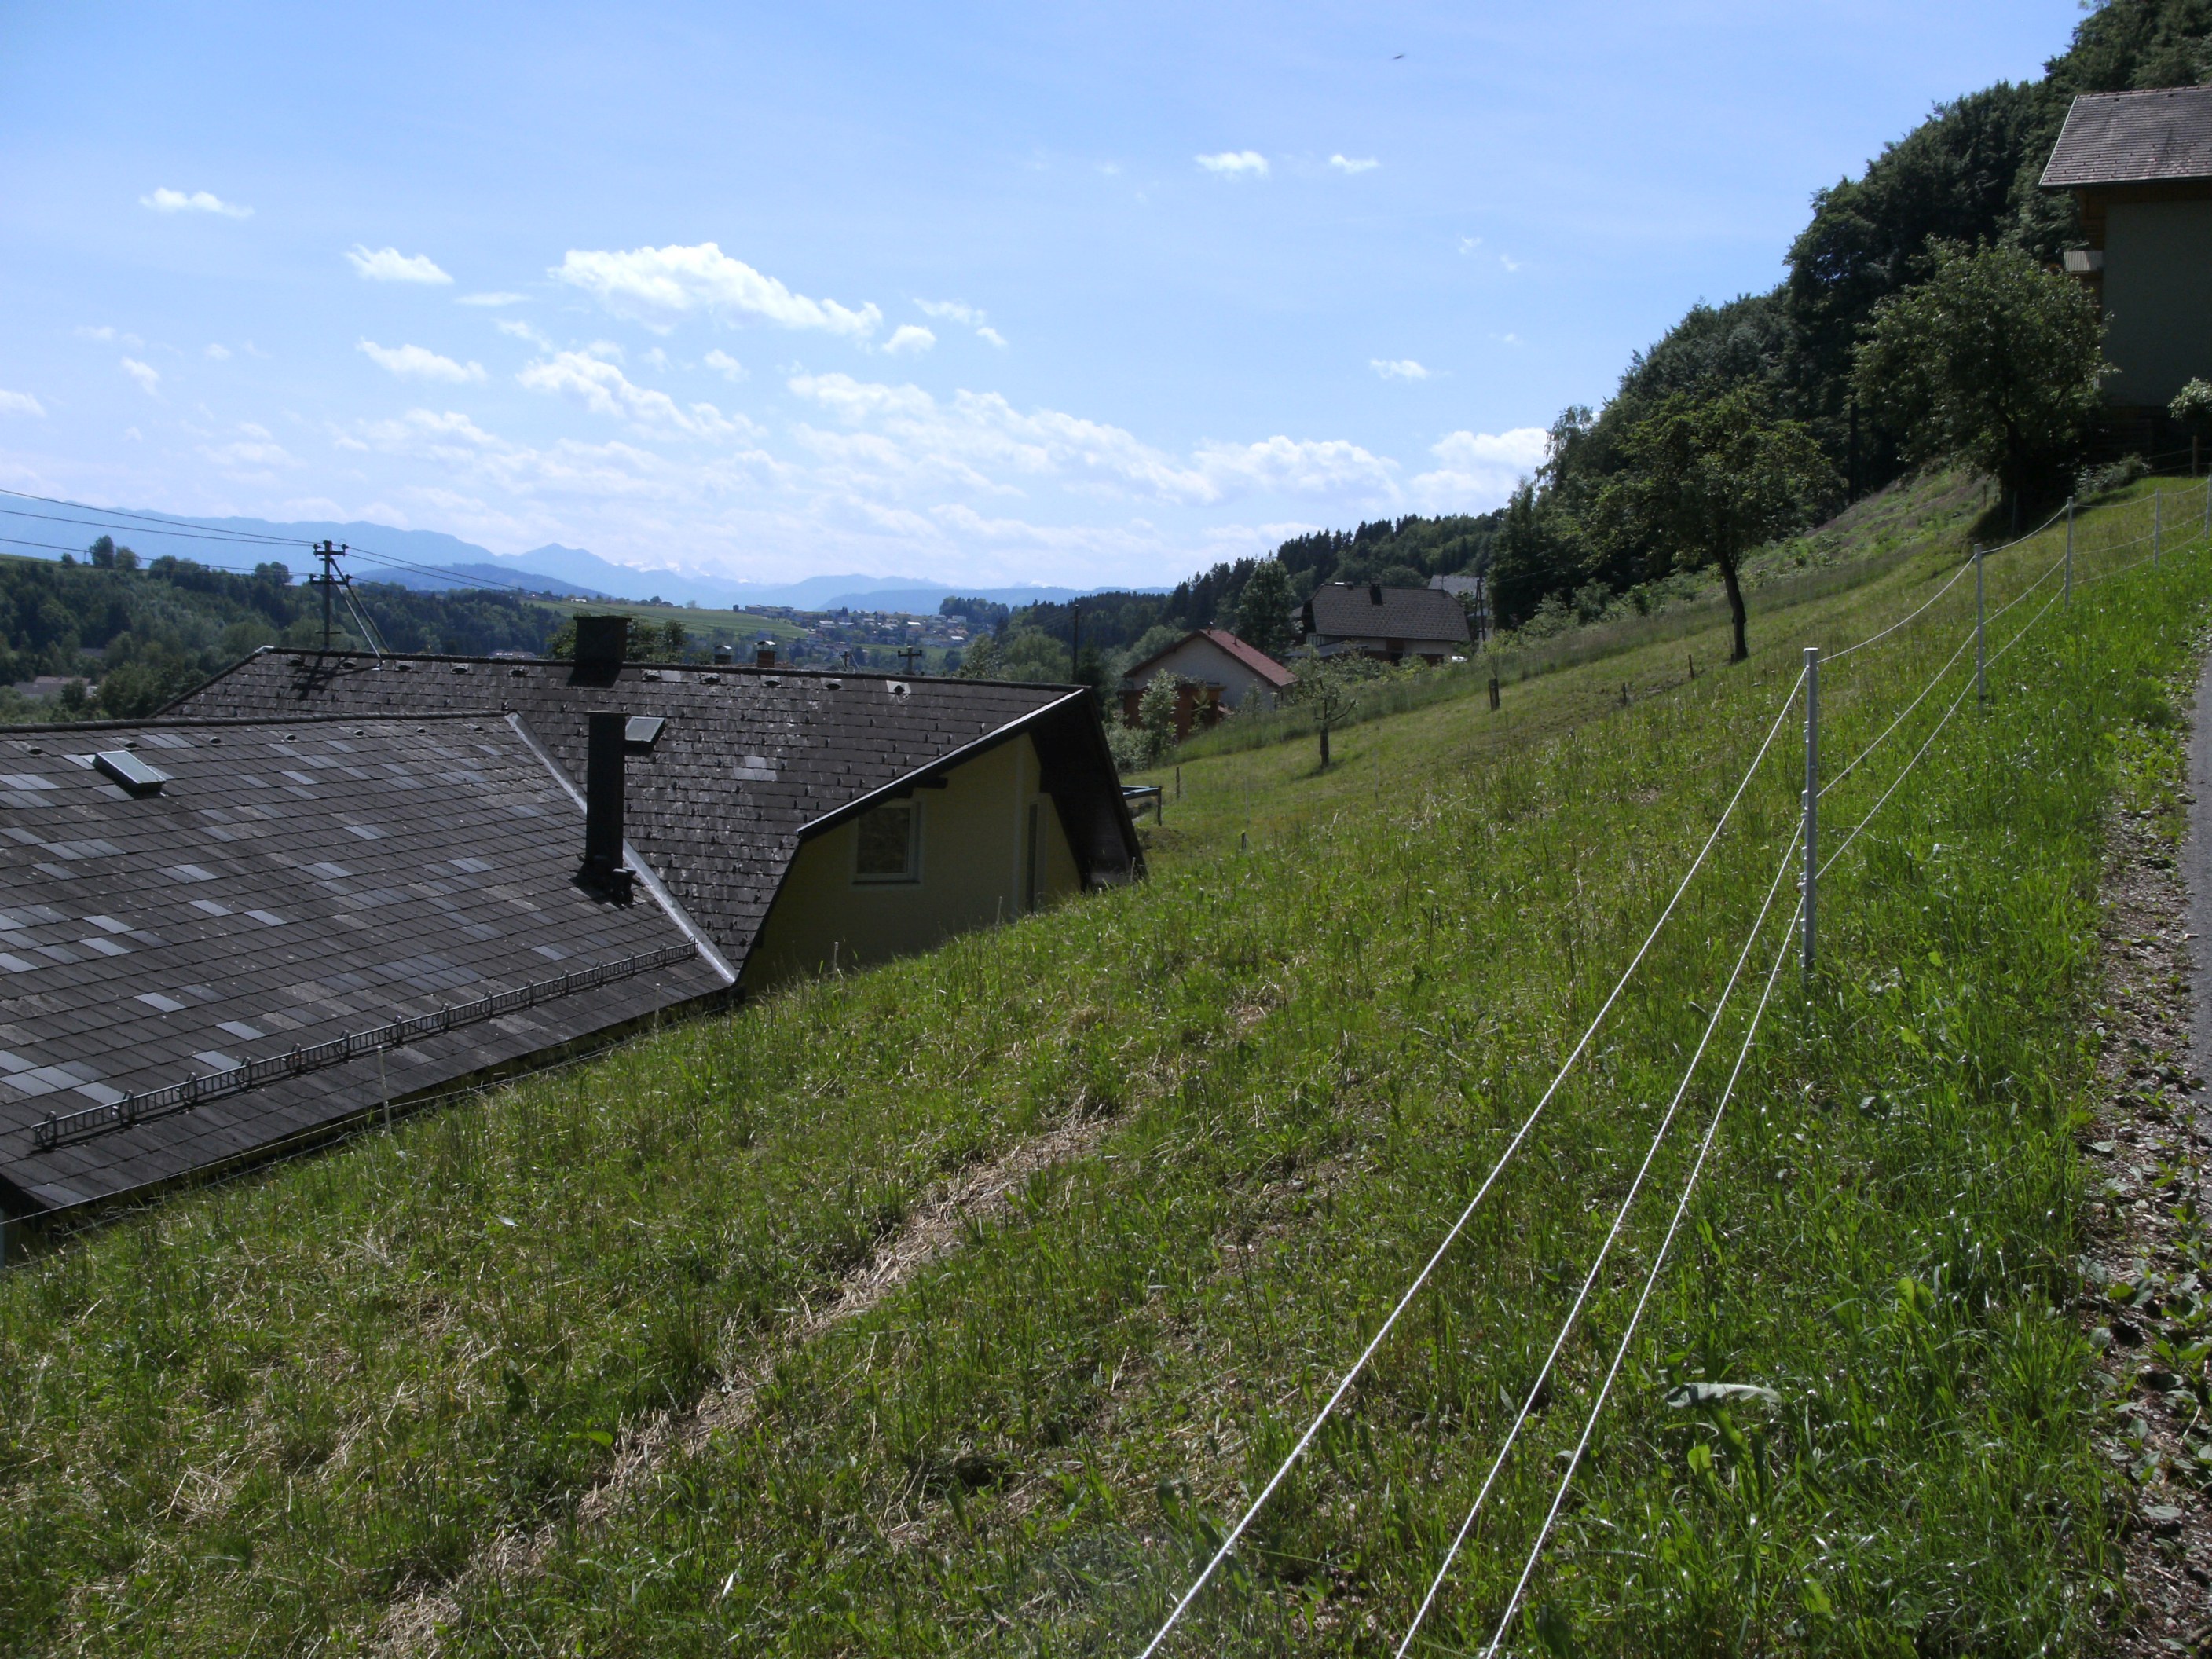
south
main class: Grassland
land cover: Grassland without tree/shrub cover
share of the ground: > 75 %
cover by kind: herbaceous plants 100 %
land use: Agriculture (excluding fallow land and kitchen gardens)
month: May
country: AT
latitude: 48.0240
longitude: 13.4987
